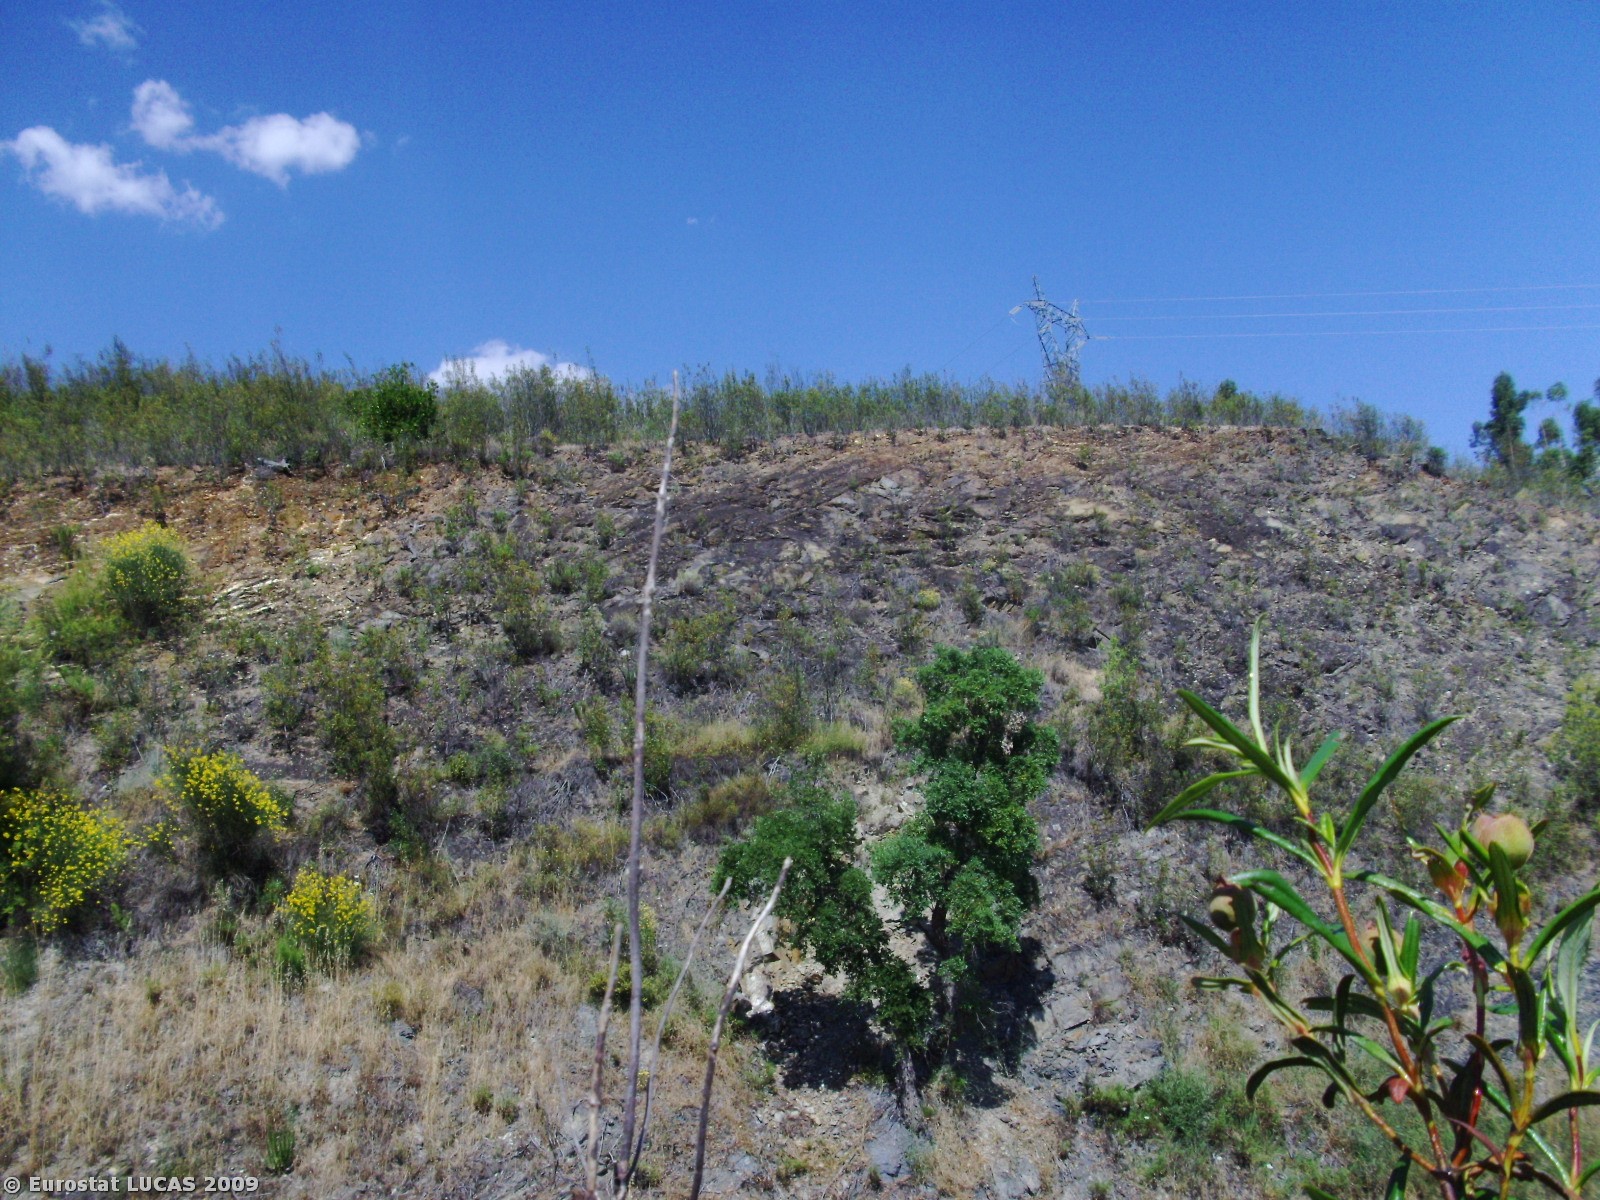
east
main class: Shrubland
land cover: Shrubland without tree cover
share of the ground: > 75 %
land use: Unused
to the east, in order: Shrubland without tree cover; Paved roads, cycling and walking lanes; Bare land; Shrubland without tree cover; Bare land; Shrubland without tree cover; Electric lines; Broadleaved woodland
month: May
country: PT
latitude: 37.4723
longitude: -8.3112
